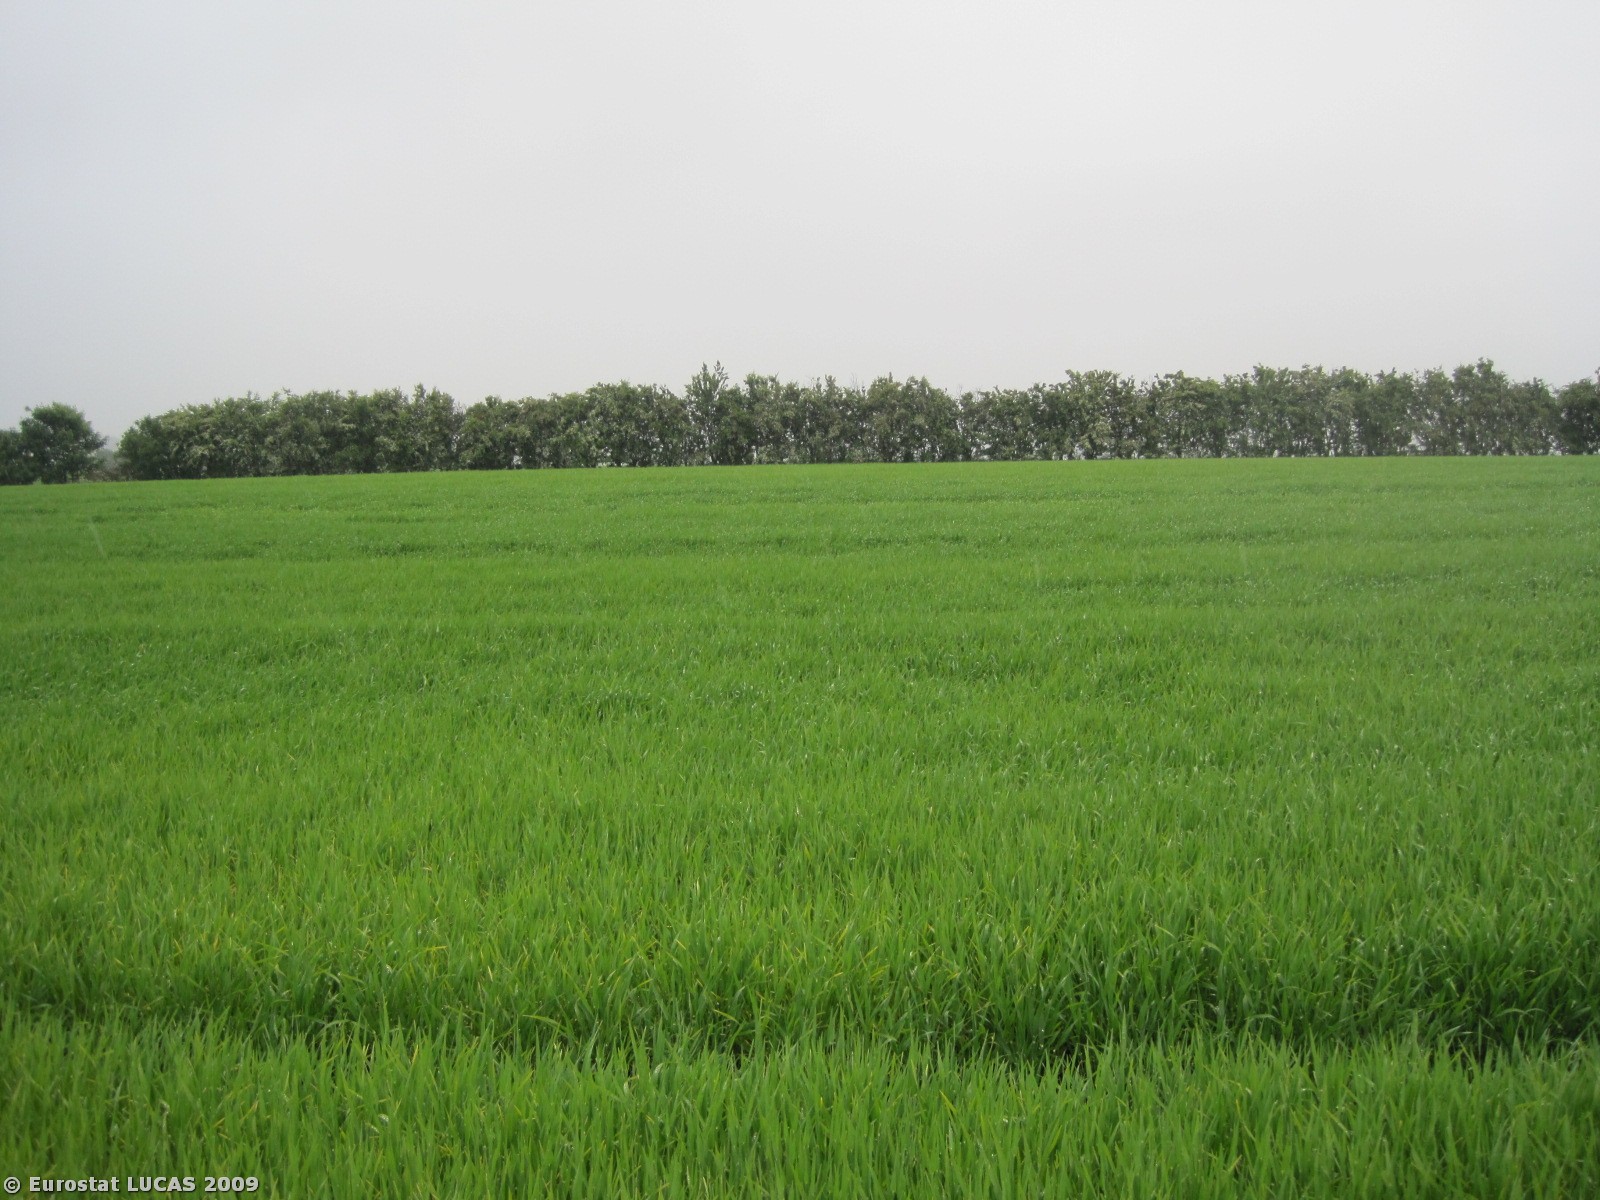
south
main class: Cropland
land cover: Barley
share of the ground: > 75 %
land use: Agriculture (excluding fallow land and kitchen gardens)
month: June
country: DK
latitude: 57.3563
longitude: 10.0830
